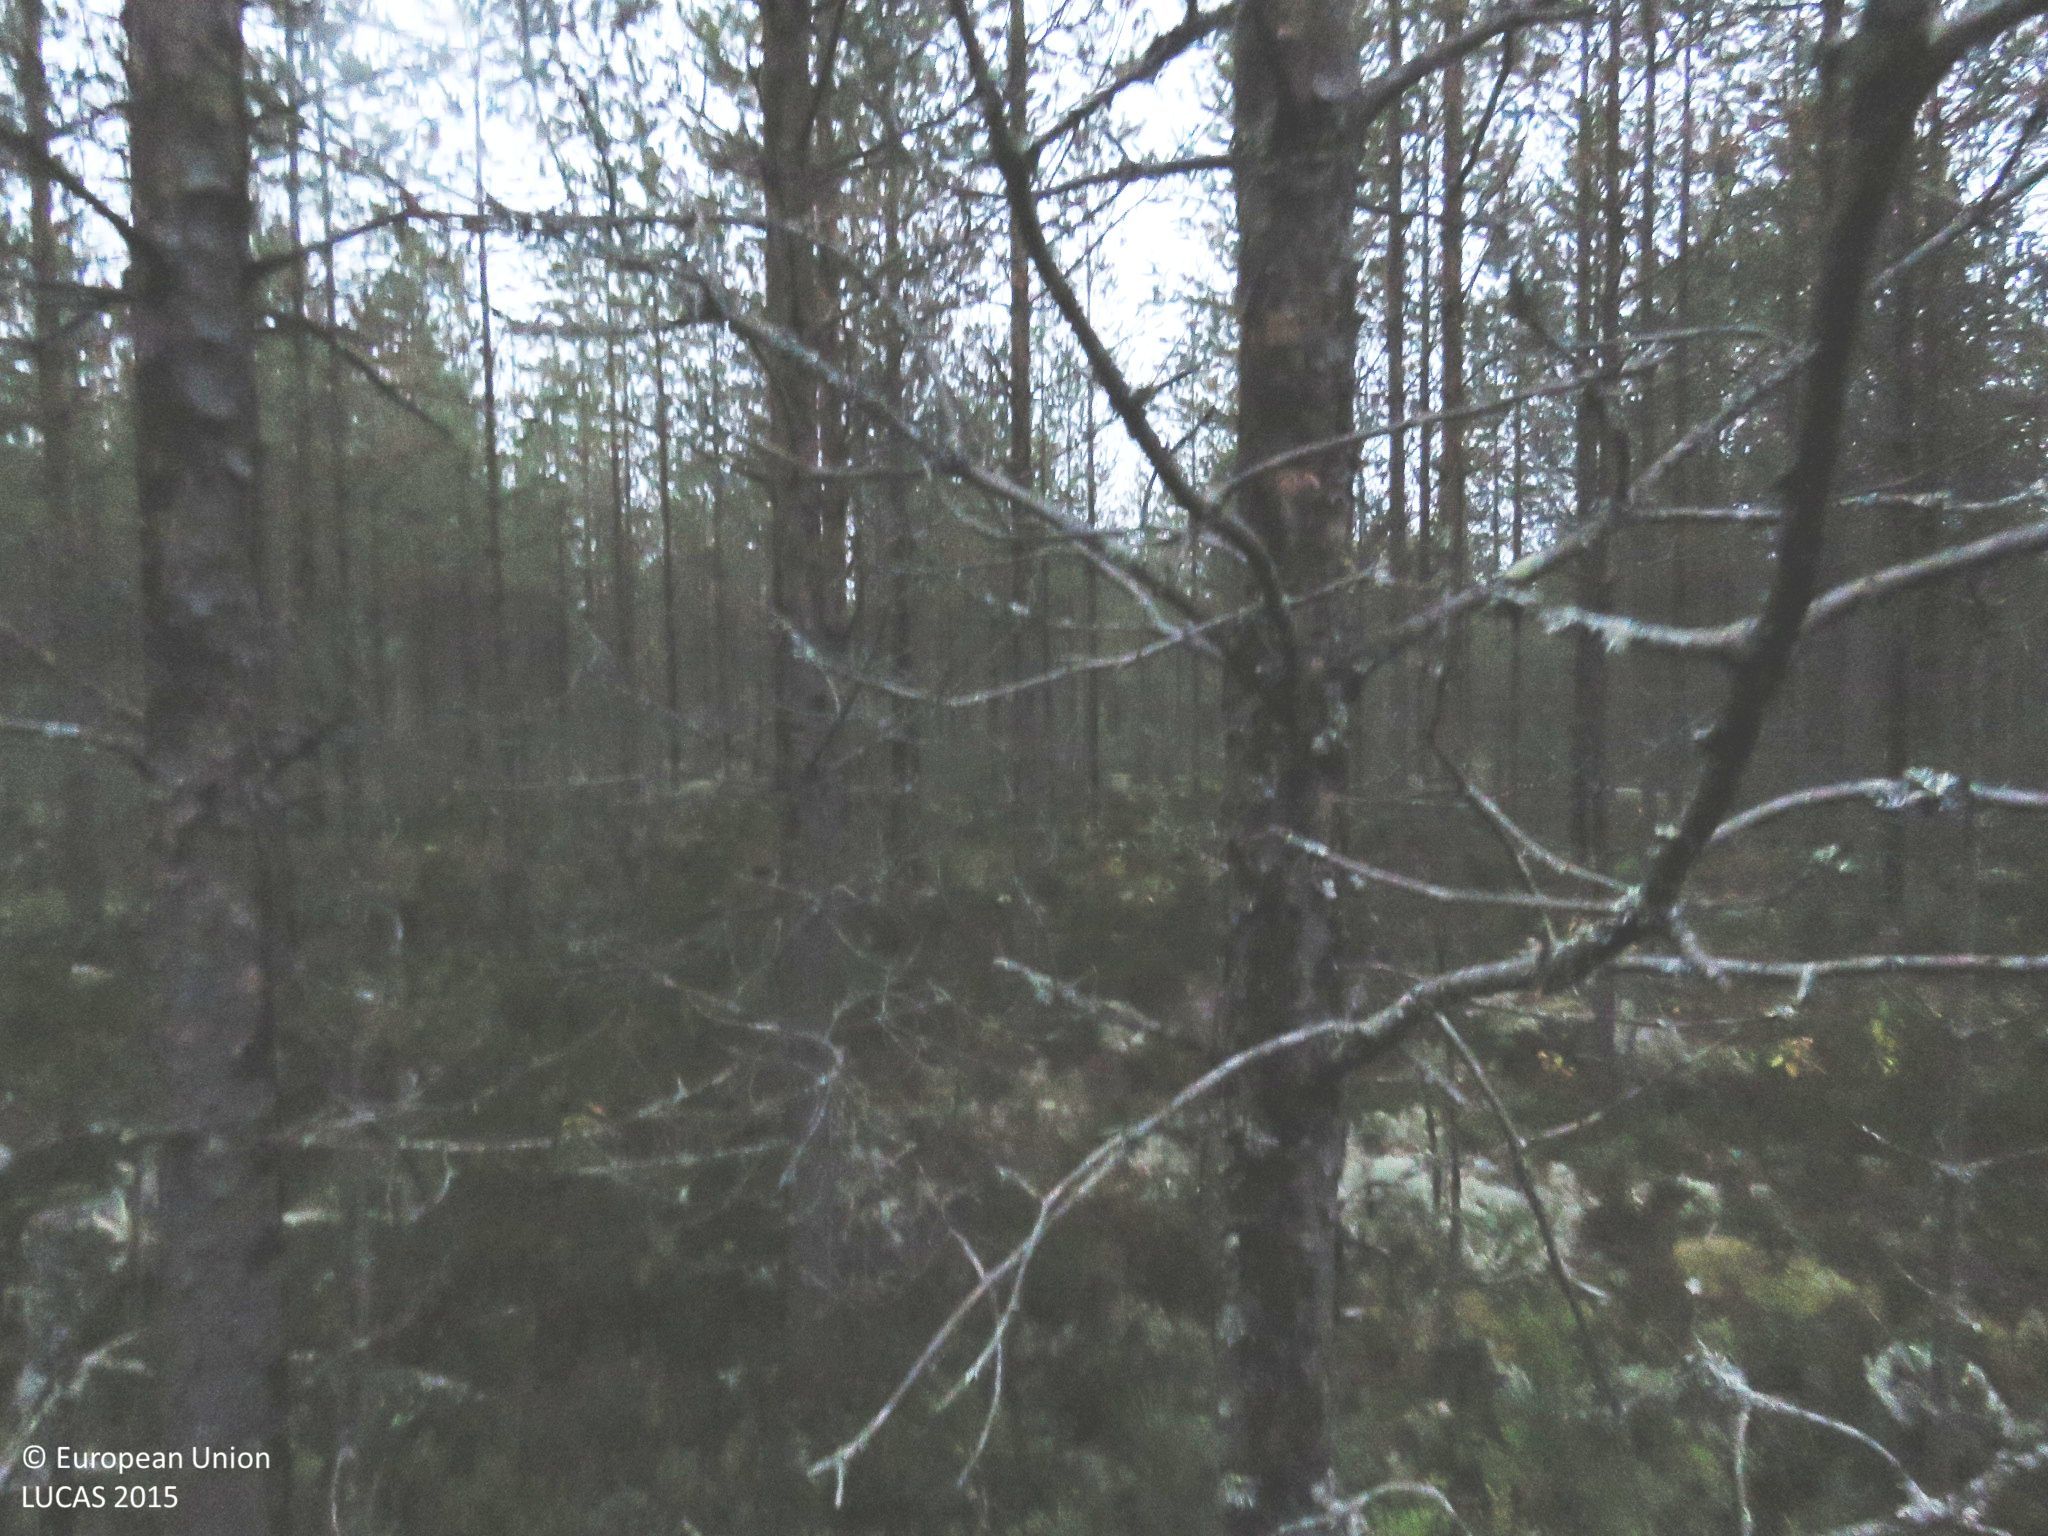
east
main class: Woodland
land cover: Pine dominated coniferous woodland
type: boreal forest
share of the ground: > 75 %
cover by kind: coniferous forest trees 65 %, shrubs 20 %, broadleaved forest trees 10 %, lichens and mosses 5 %
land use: Forestry
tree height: > 5 m
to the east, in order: Pine dominated coniferous woodland; Ditches and canals; Shruby margins; Tracks; Shruby margins; Ditches and canals; Pine dominated coniferous woodland; Ditches and canals; Pine dominated mixed woodland
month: September
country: FI
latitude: 64.7955
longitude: 26.5922
